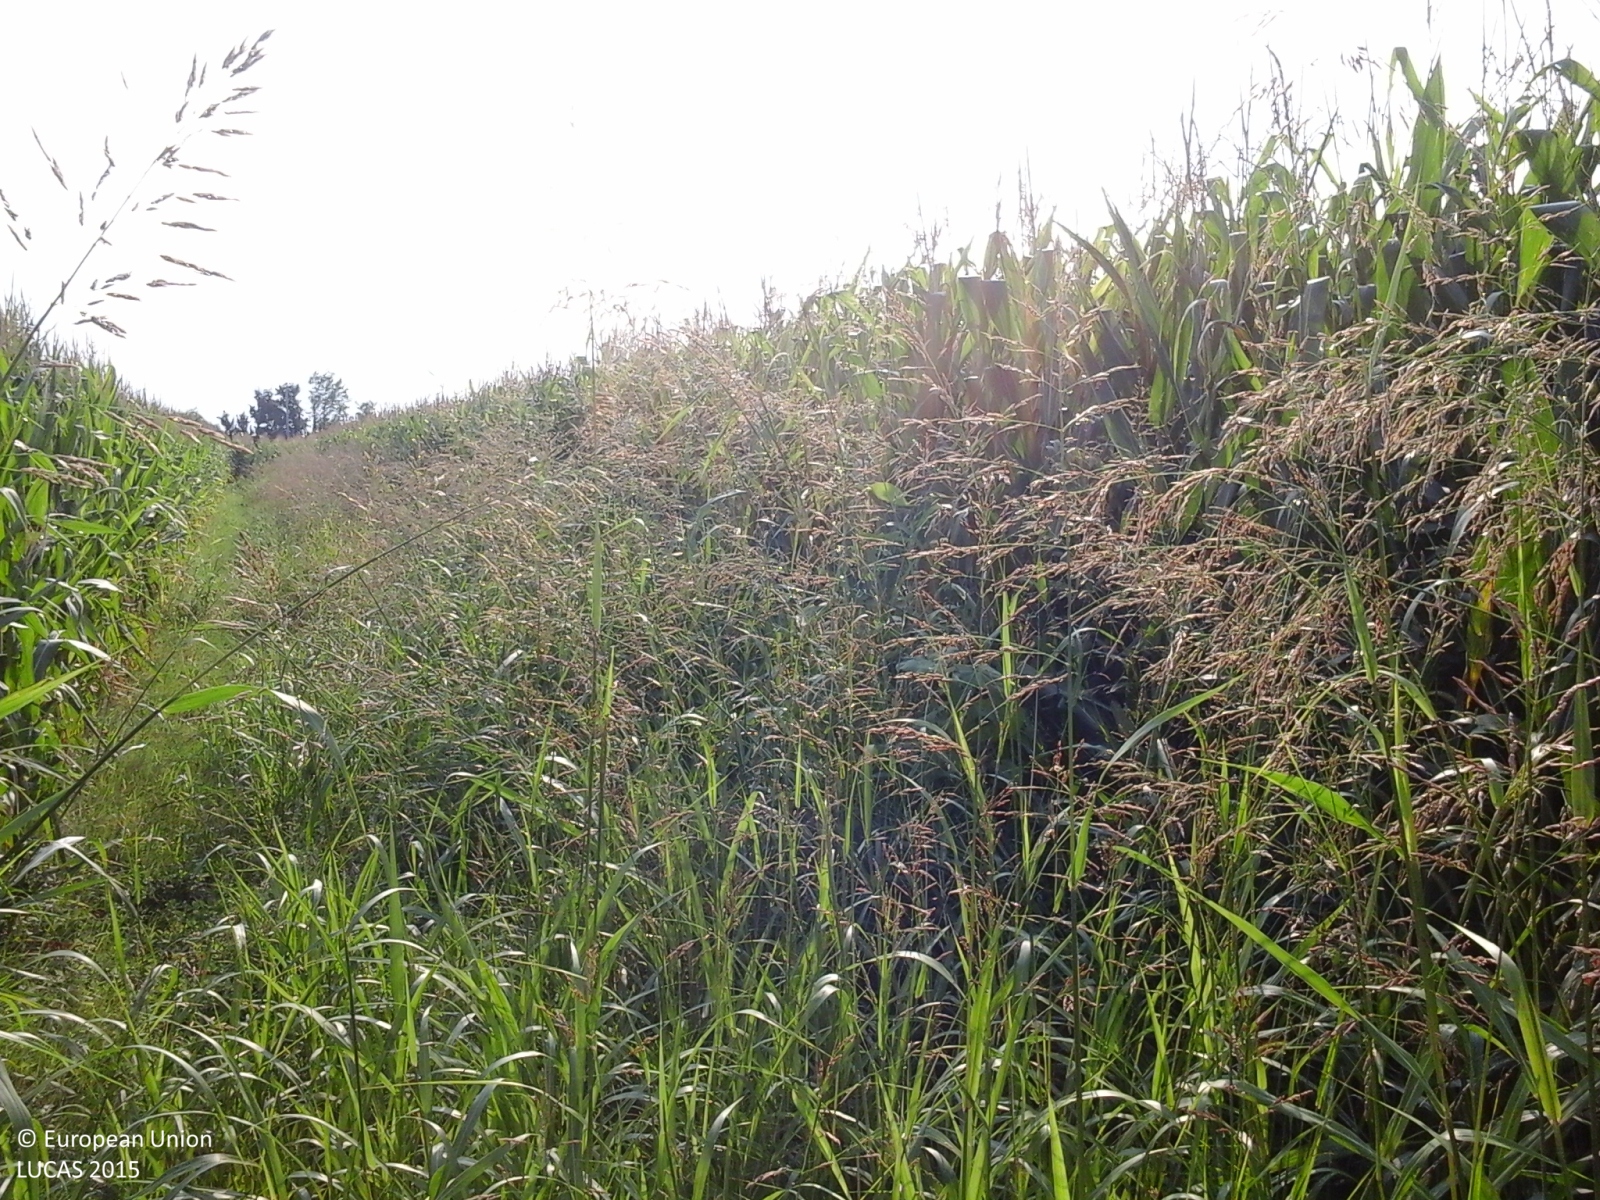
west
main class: Cropland
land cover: Maize
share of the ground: > 75 %
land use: Agriculture (excluding fallow land and kitchen gardens)
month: June
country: IT
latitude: 45.9276
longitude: 12.4083
